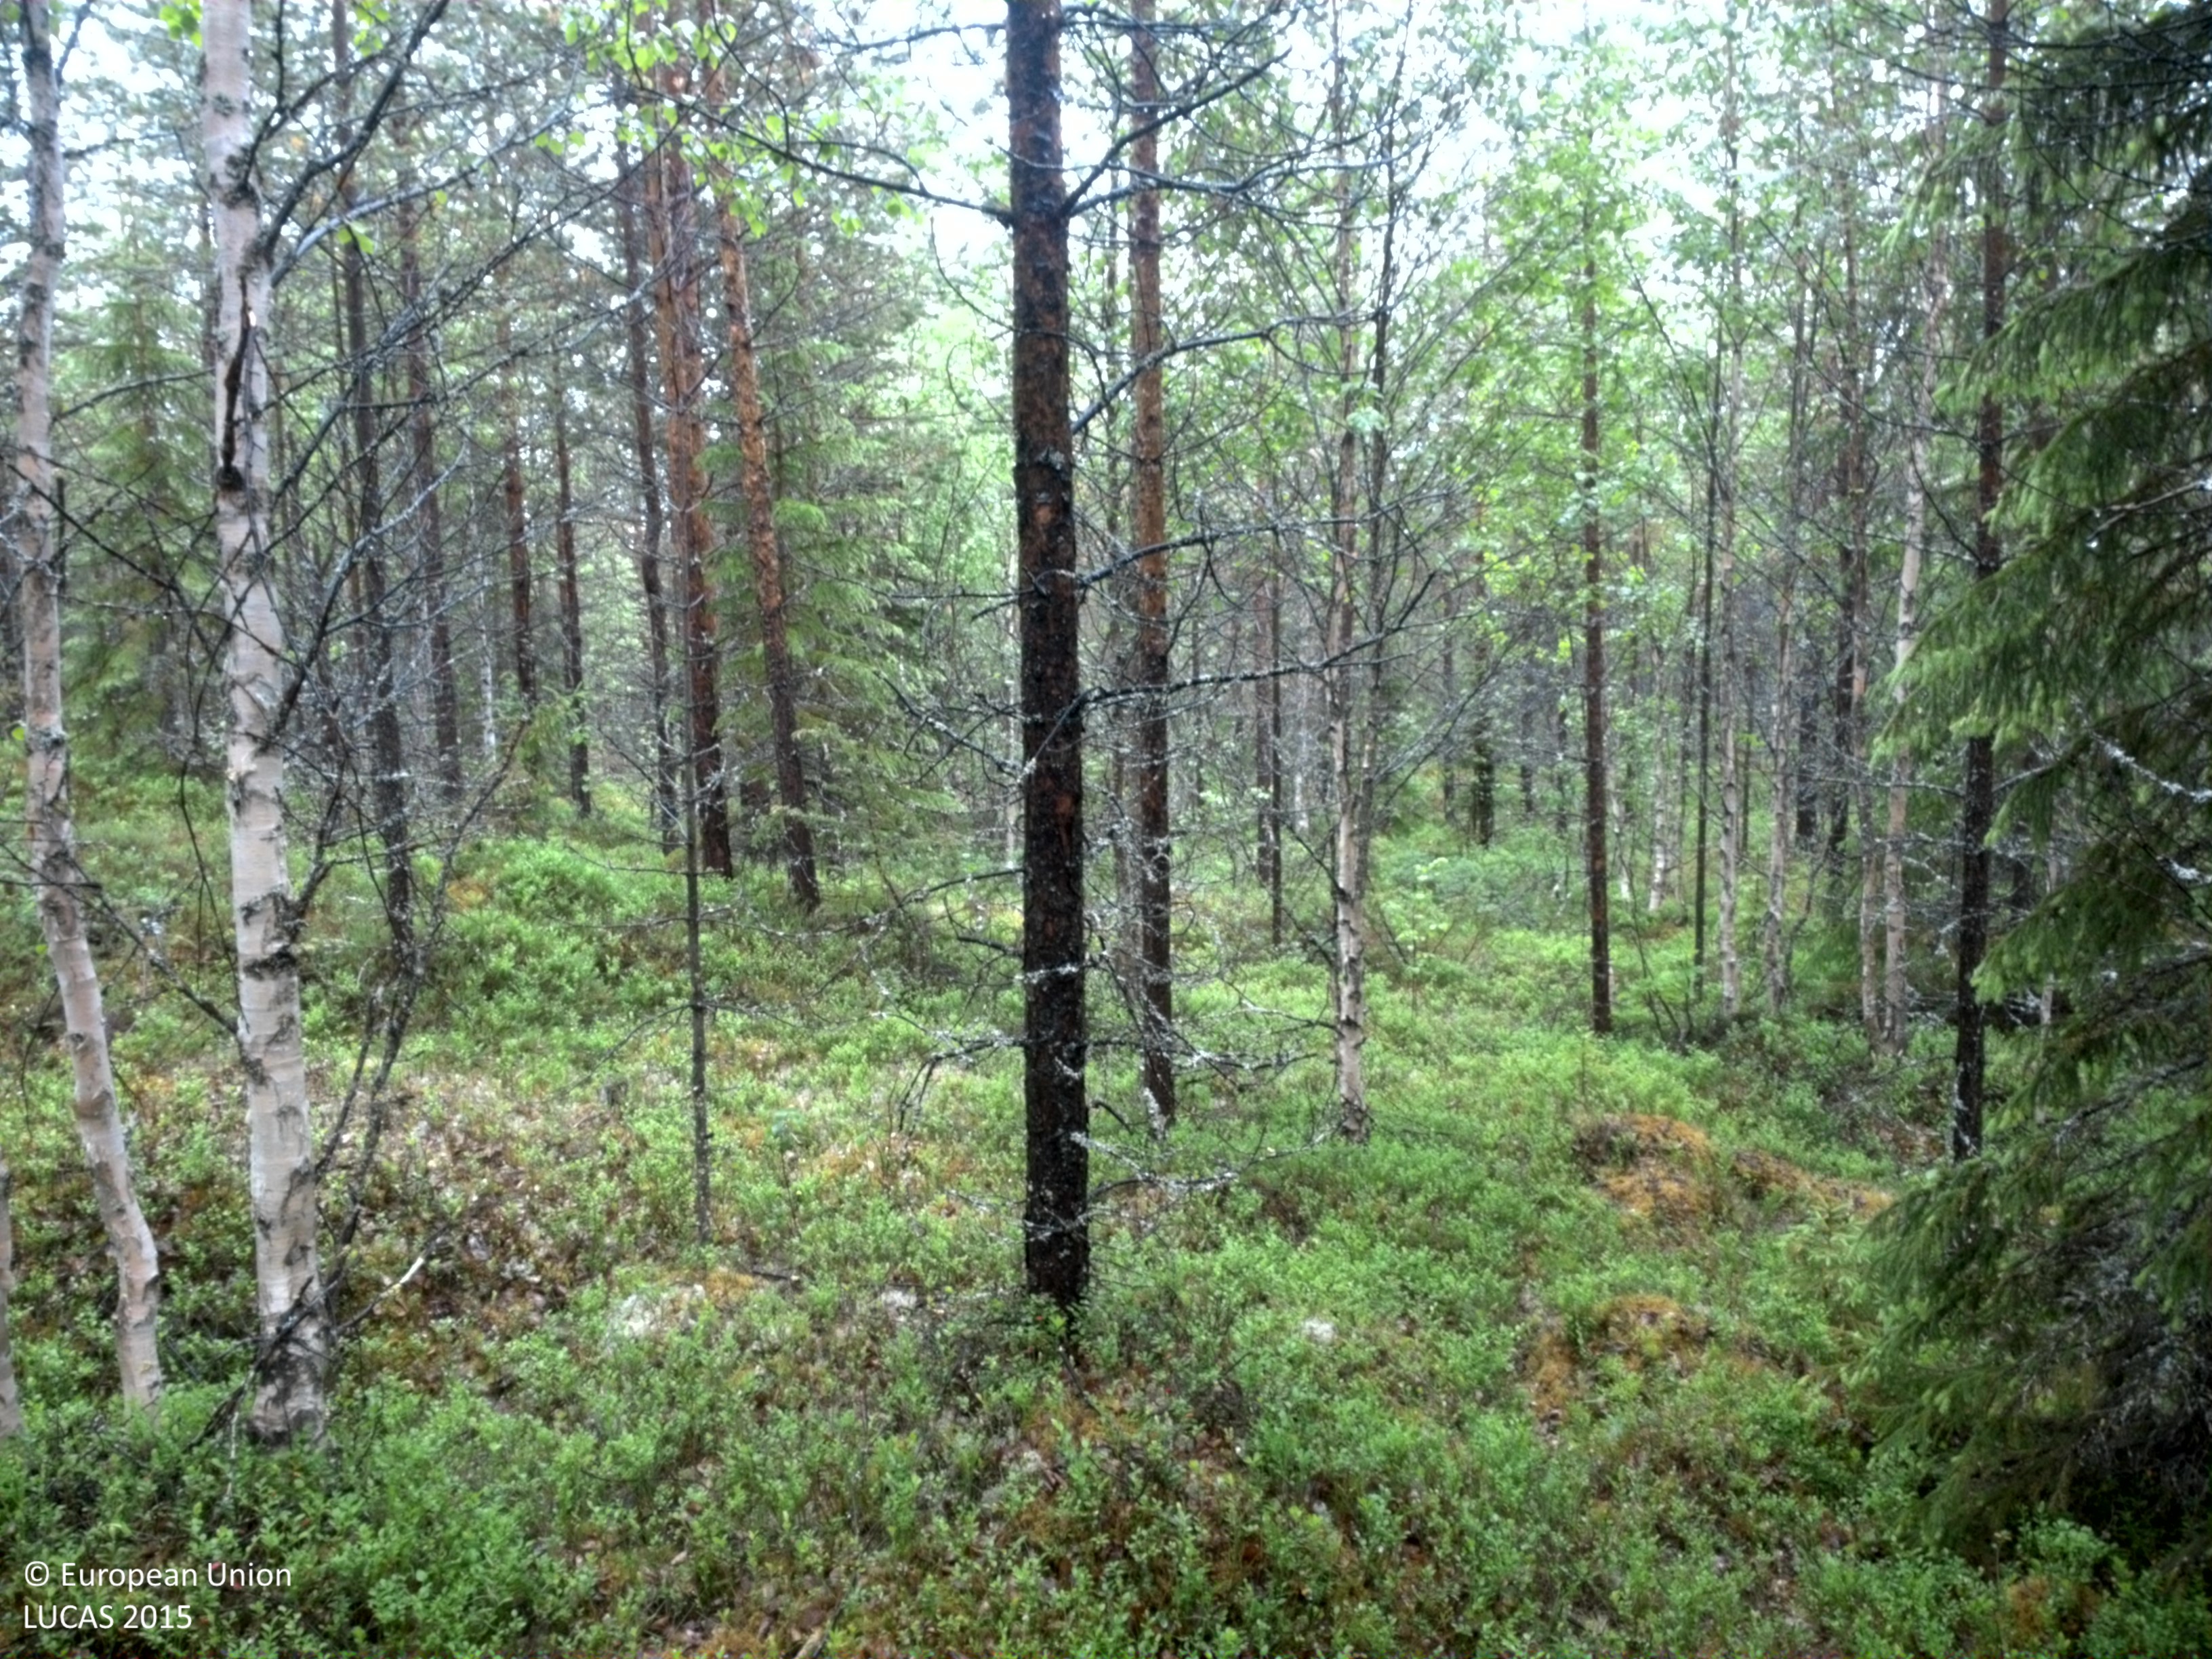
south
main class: Woodland
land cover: Other mixed woodland
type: boreal forest
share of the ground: 50 - 75 %
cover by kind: coniferous forest trees 45 %, shrubs 30 %, broadleaved forest trees 15 %, lichens and mosses 10 %
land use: Forestry
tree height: > 5 m
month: July
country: SE
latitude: 64.5892
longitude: 18.1336
